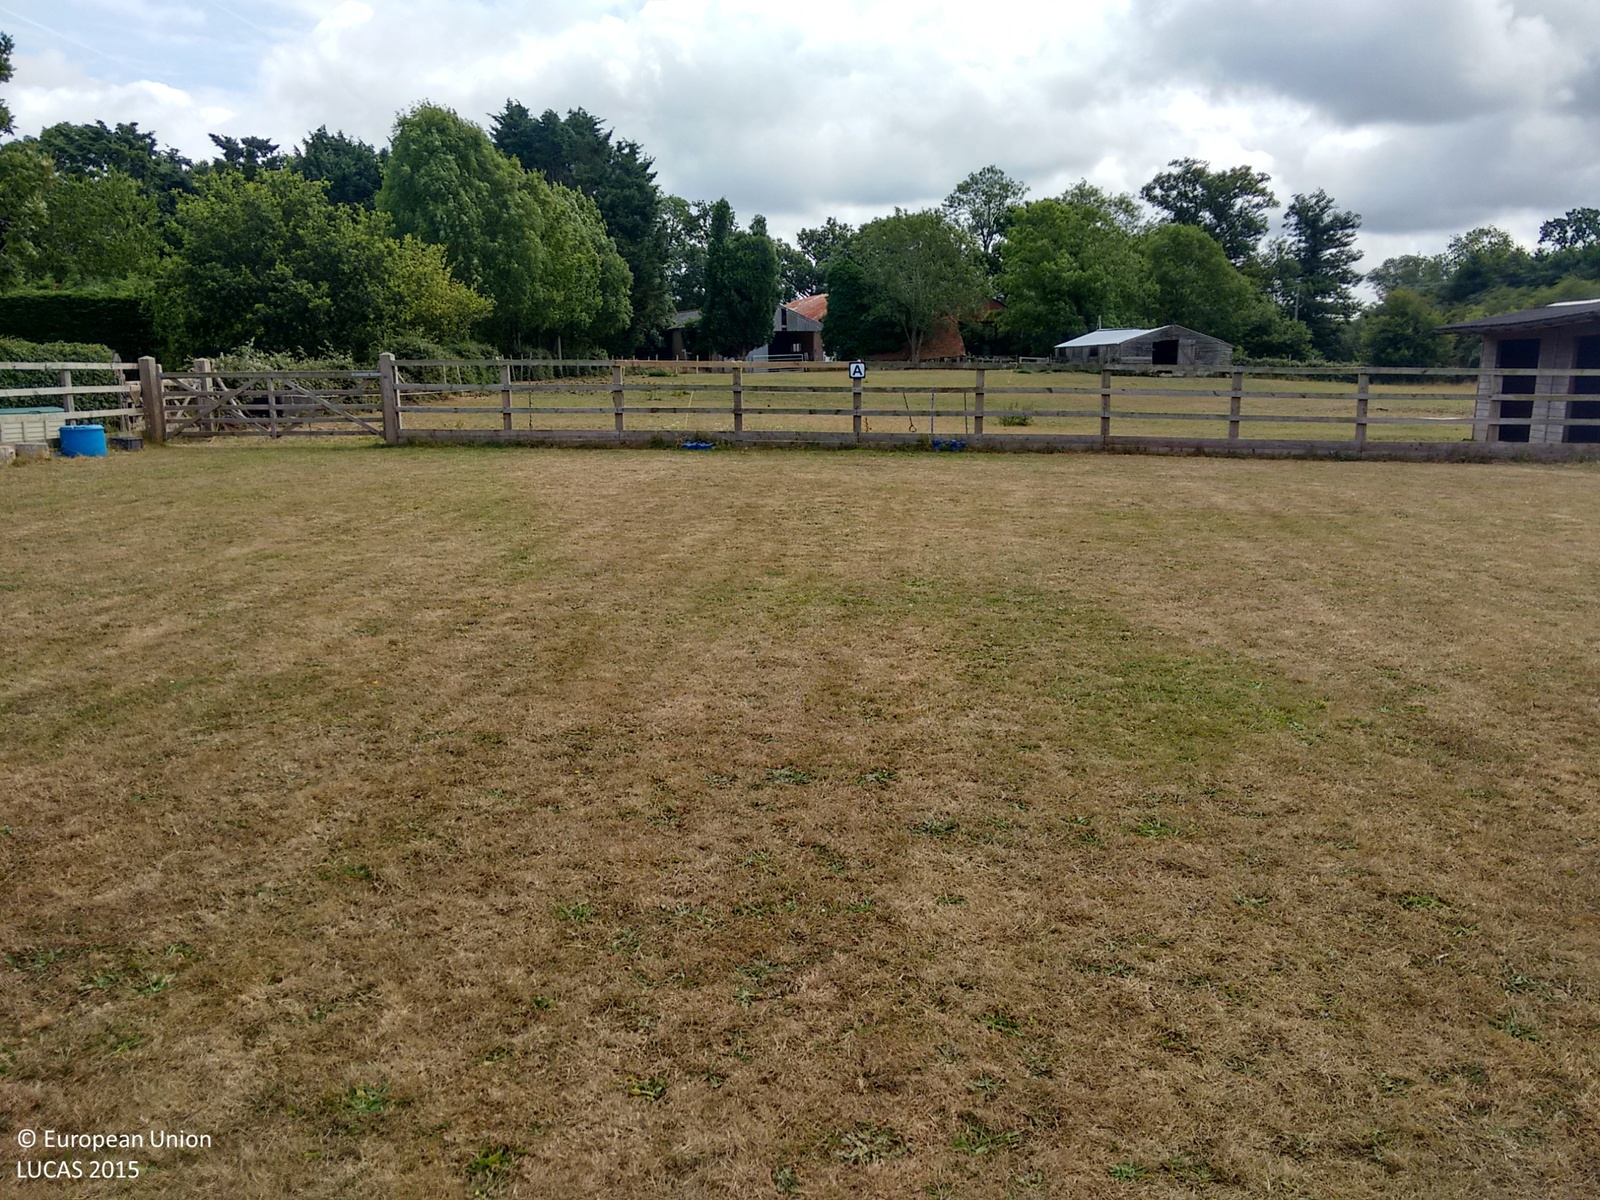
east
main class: Grassland
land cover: Grassland without tree/shrub cover
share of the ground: > 75 %
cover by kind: herbaceous plants 100 %
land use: Agriculture (excluding fallow land and kitchen gardens)
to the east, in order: Grassland without tree/shrub cover; Fences; Grassland without tree/shrub cover; Fences; Grassland without tree/shrub cover; Fences; Managed hedges; Artificial constructions in urban areas; Broadleaved woodland; Fences; Tracks; Managed hedges; Fences; Spontaneously vegetated surfaces; Maize
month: July
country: GB
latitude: 51.0840
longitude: -0.4157
